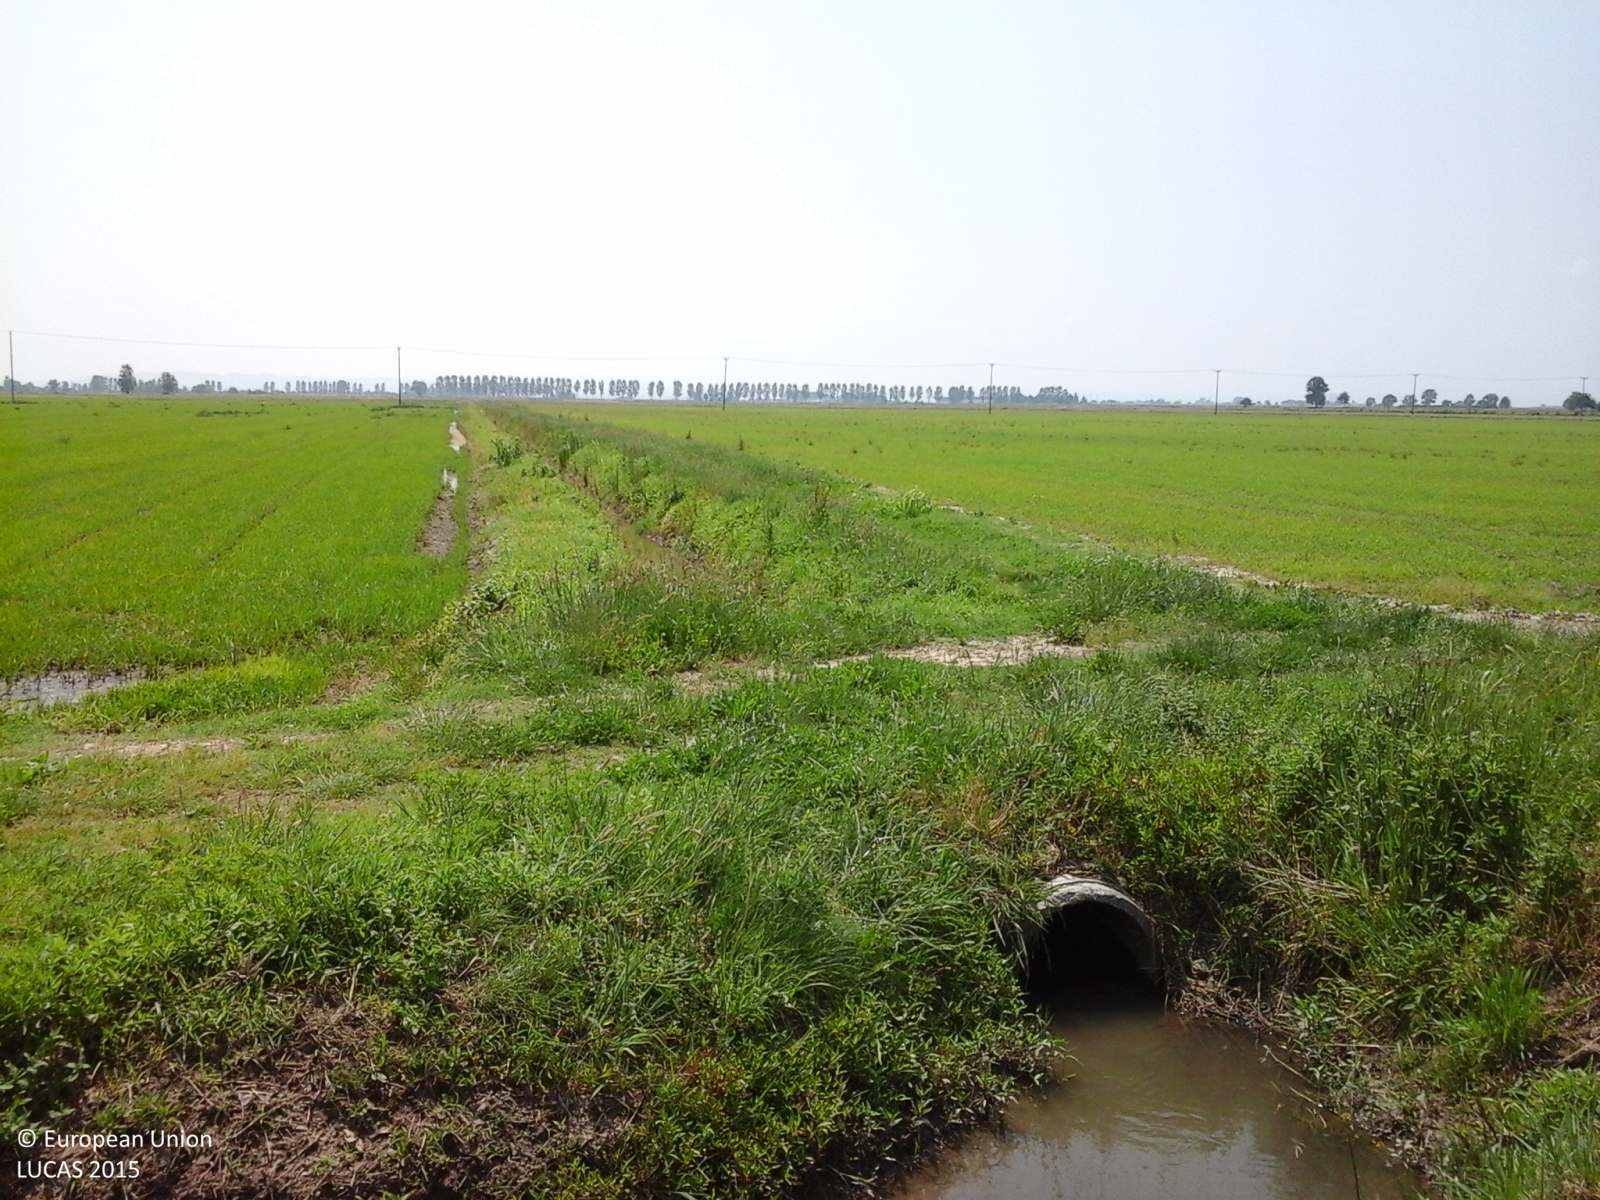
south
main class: Cropland
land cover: Rice
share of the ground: 25 - 50 %
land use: Agriculture (excluding fallow land and kitchen gardens)
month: May
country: IT
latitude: 45.3286
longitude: 8.3060
